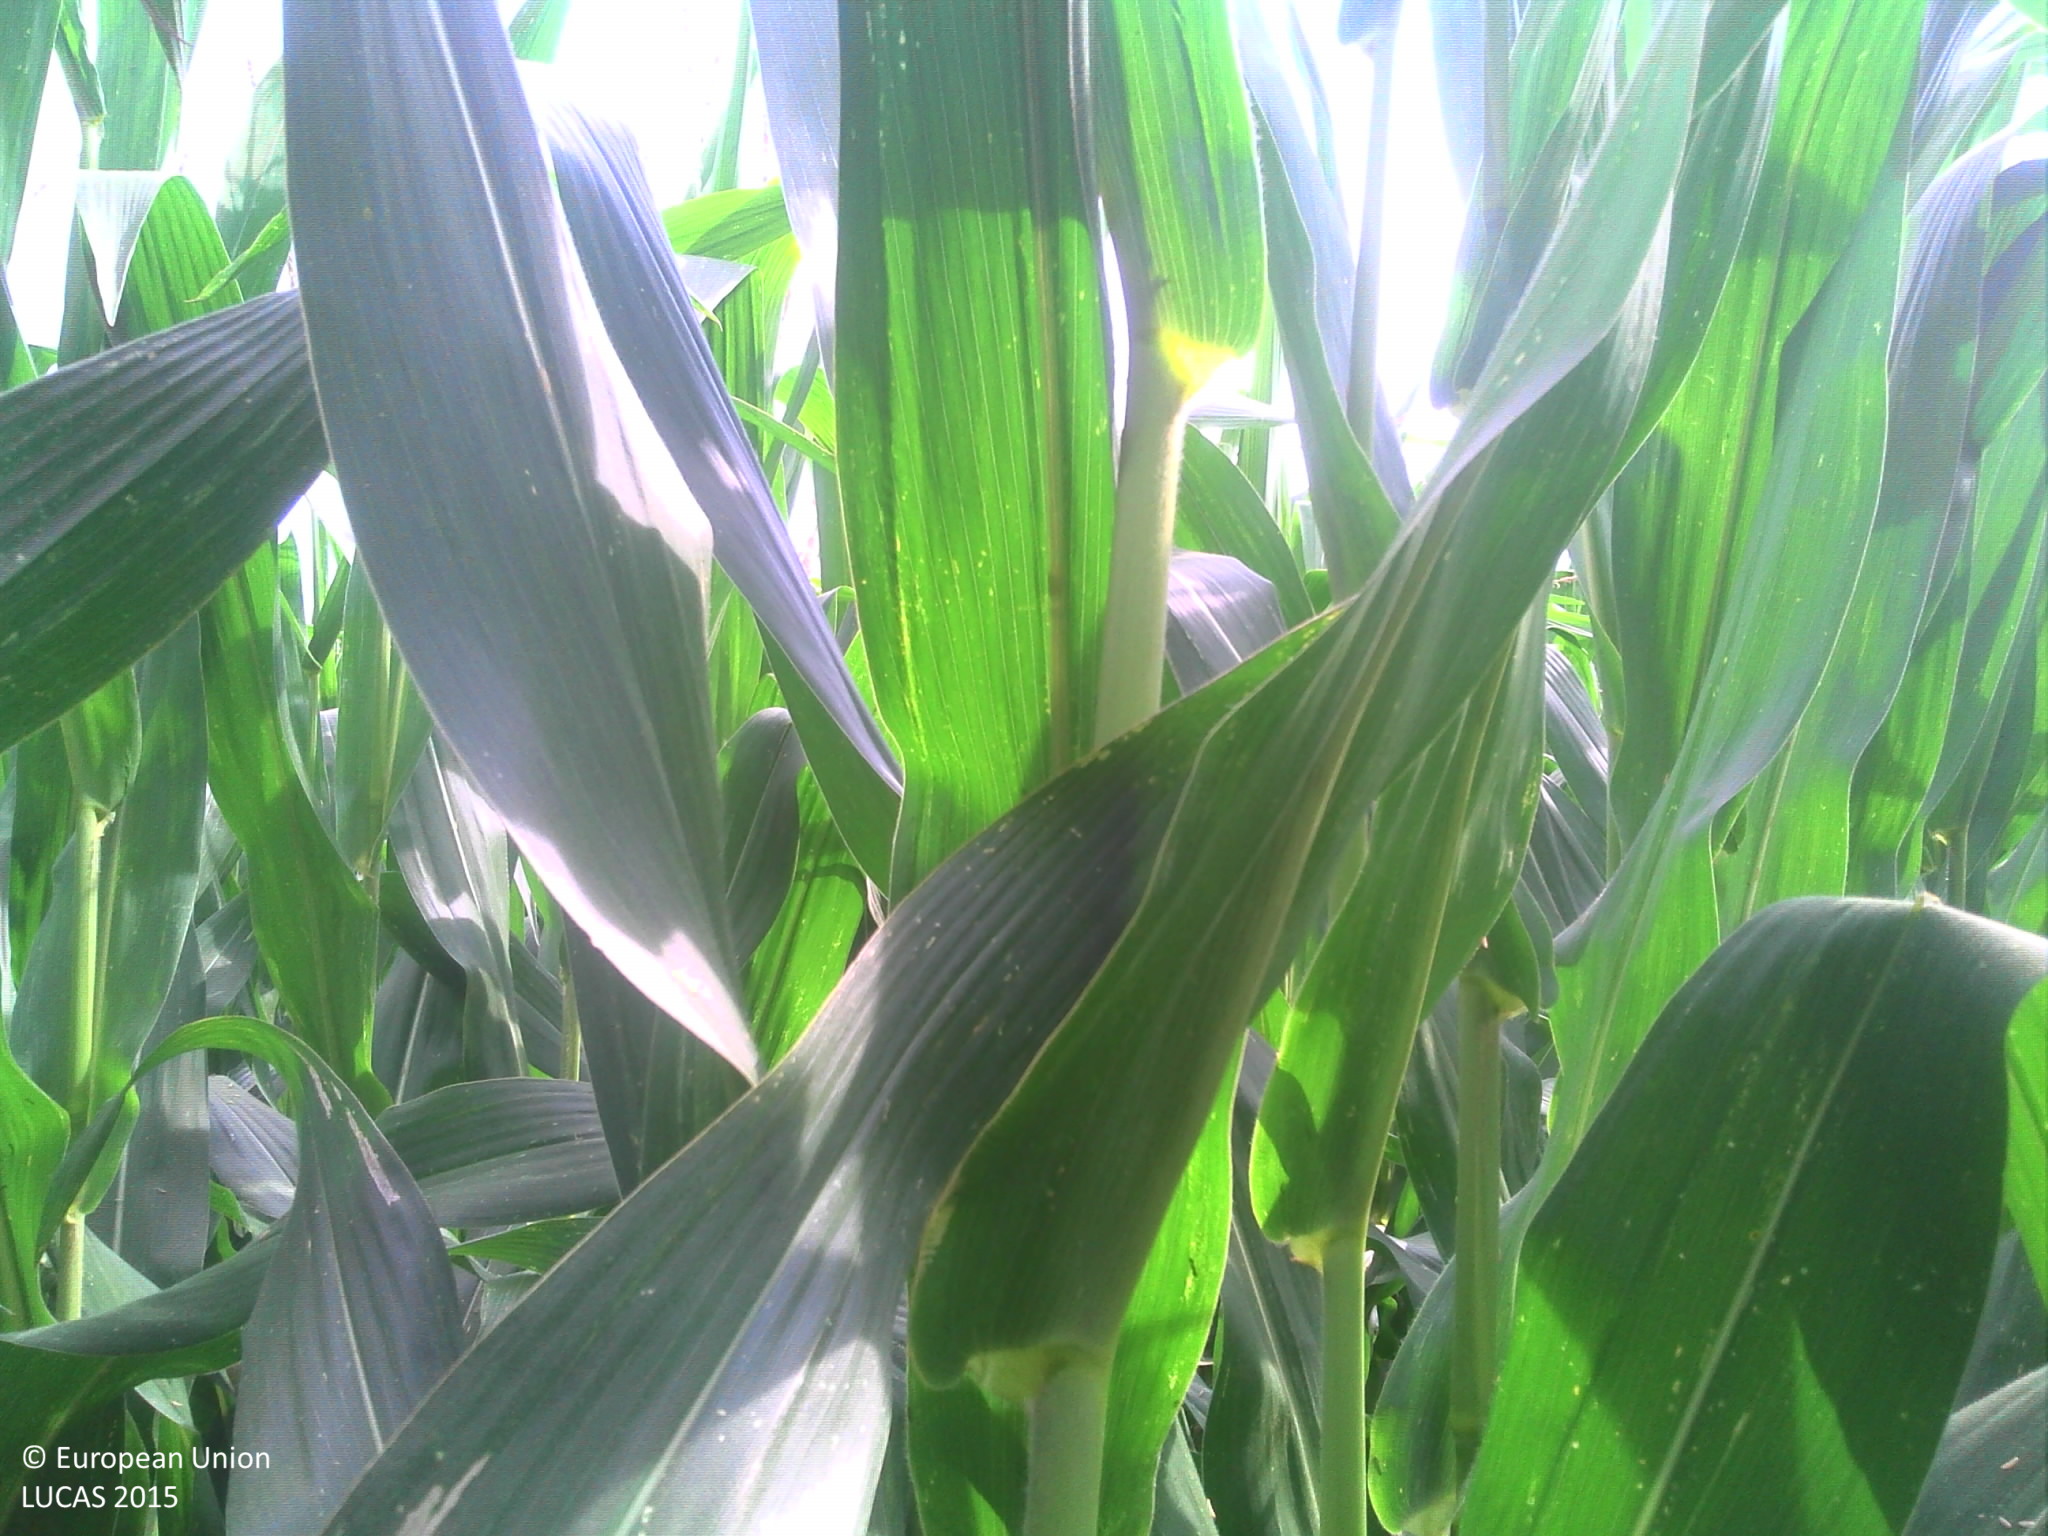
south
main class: Cropland
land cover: Maize
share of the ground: > 75 %
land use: Agriculture (excluding fallow land and kitchen gardens)
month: July
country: FR
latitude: 43.3914
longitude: 1.1507
